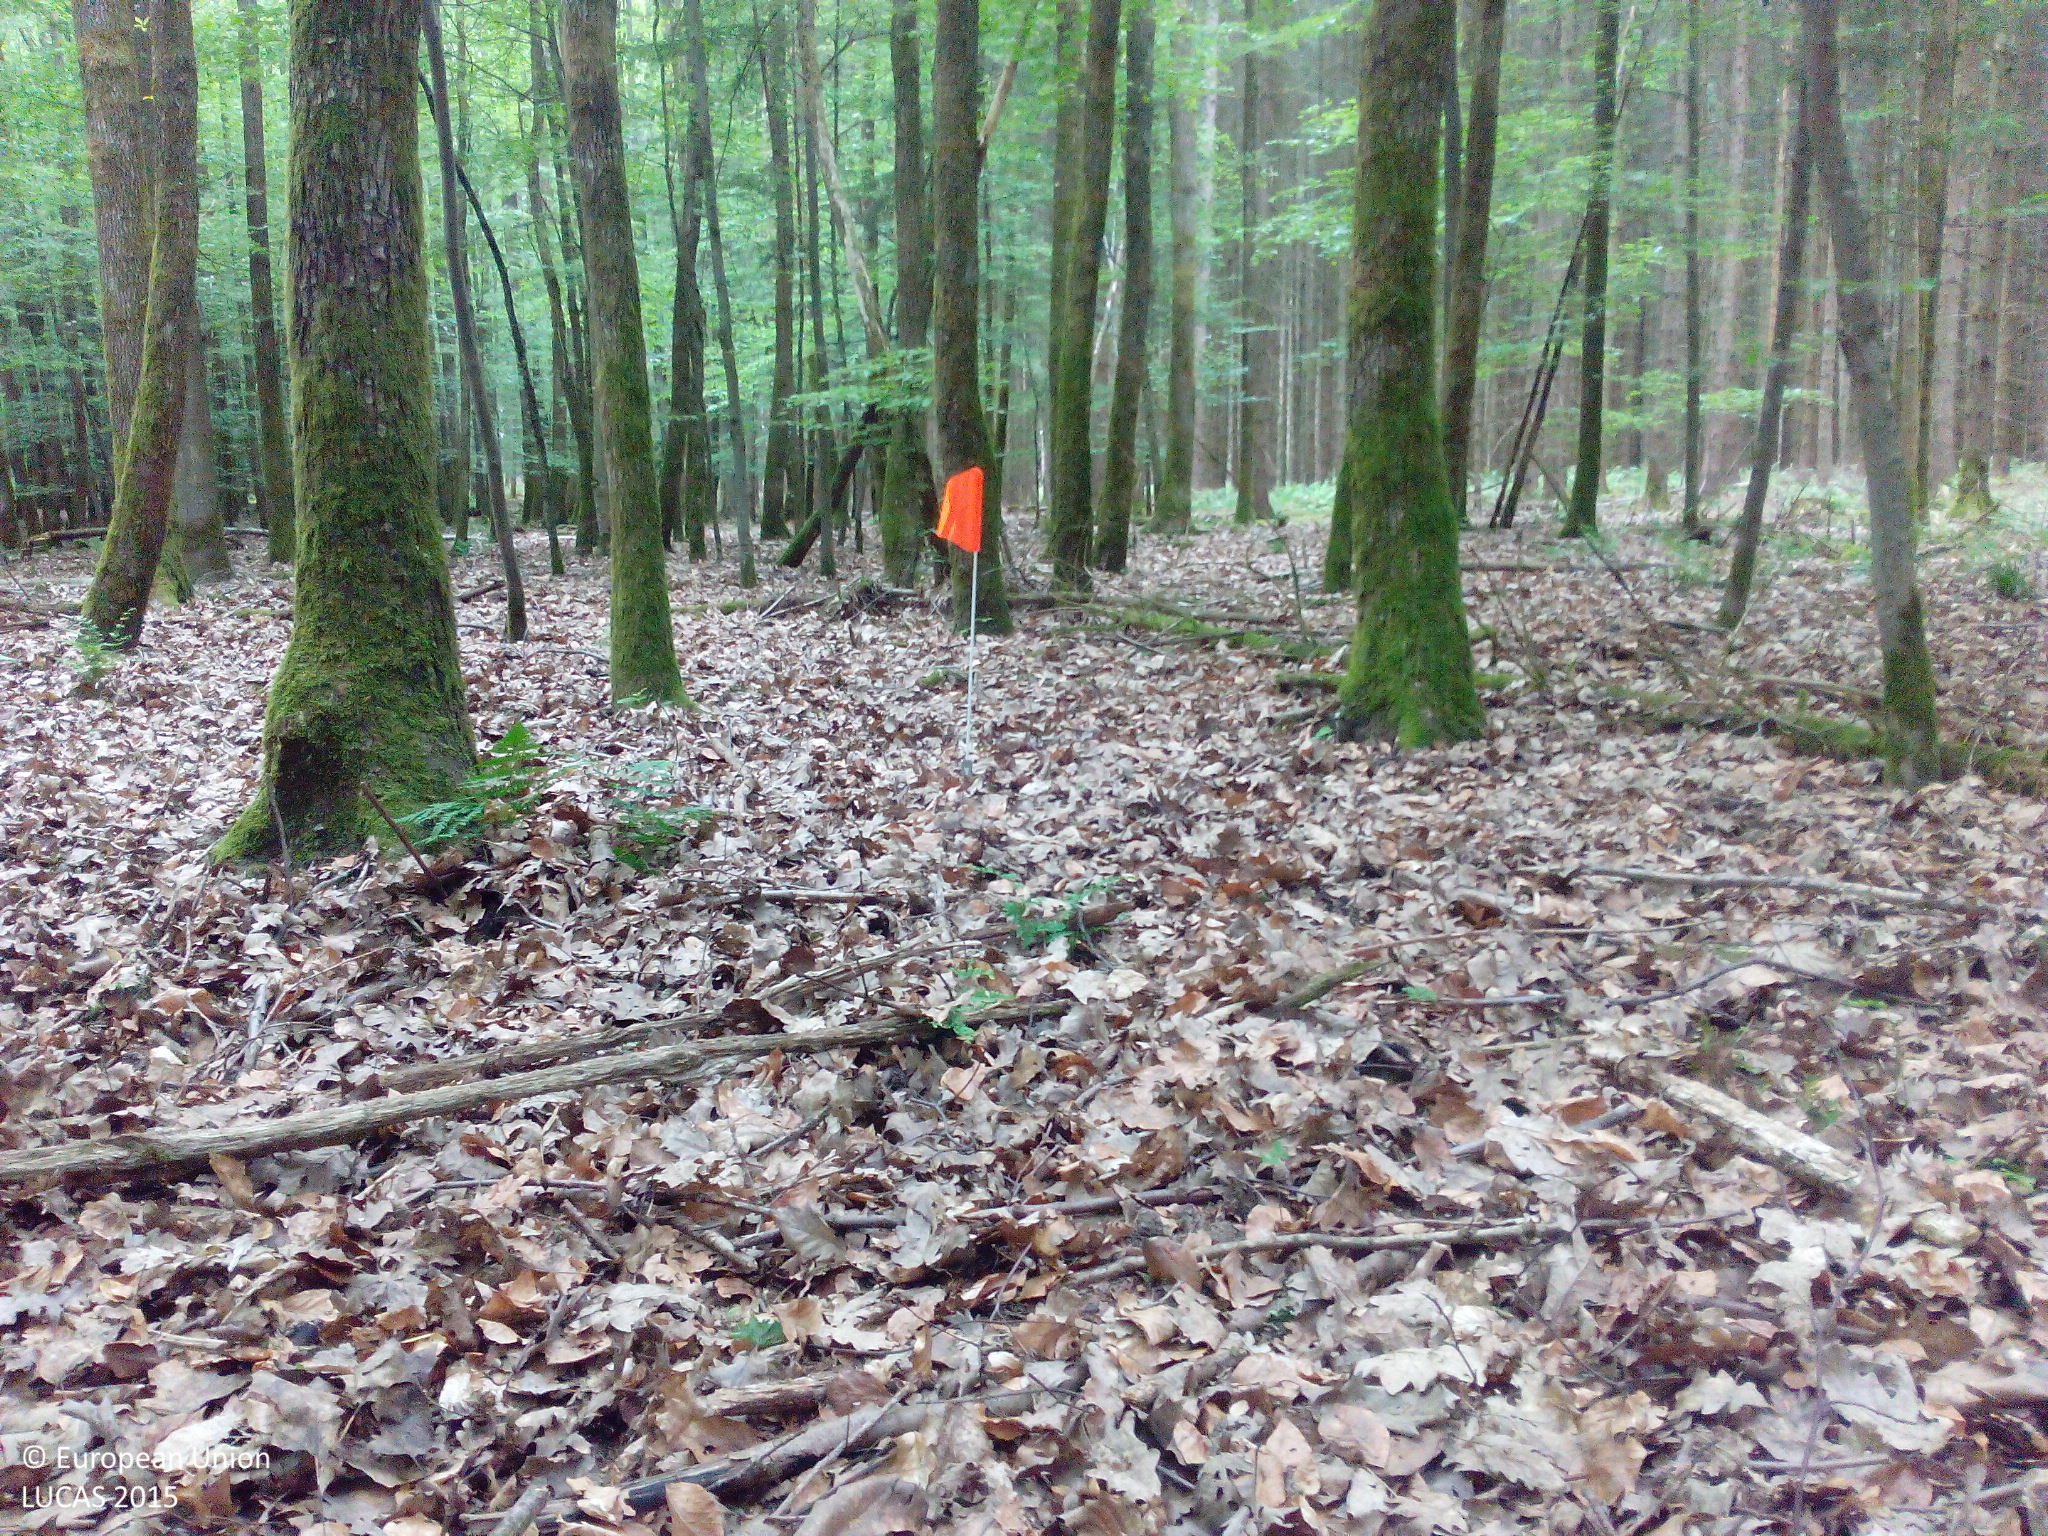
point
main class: Woodland
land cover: Broadleaved woodland
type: mesophytic deciduous forest
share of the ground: > 75 %
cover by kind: broadleaved forest trees 100 %
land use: Forestry
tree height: > 5 m
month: May
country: DE
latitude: 49.3360
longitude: 9.1884
